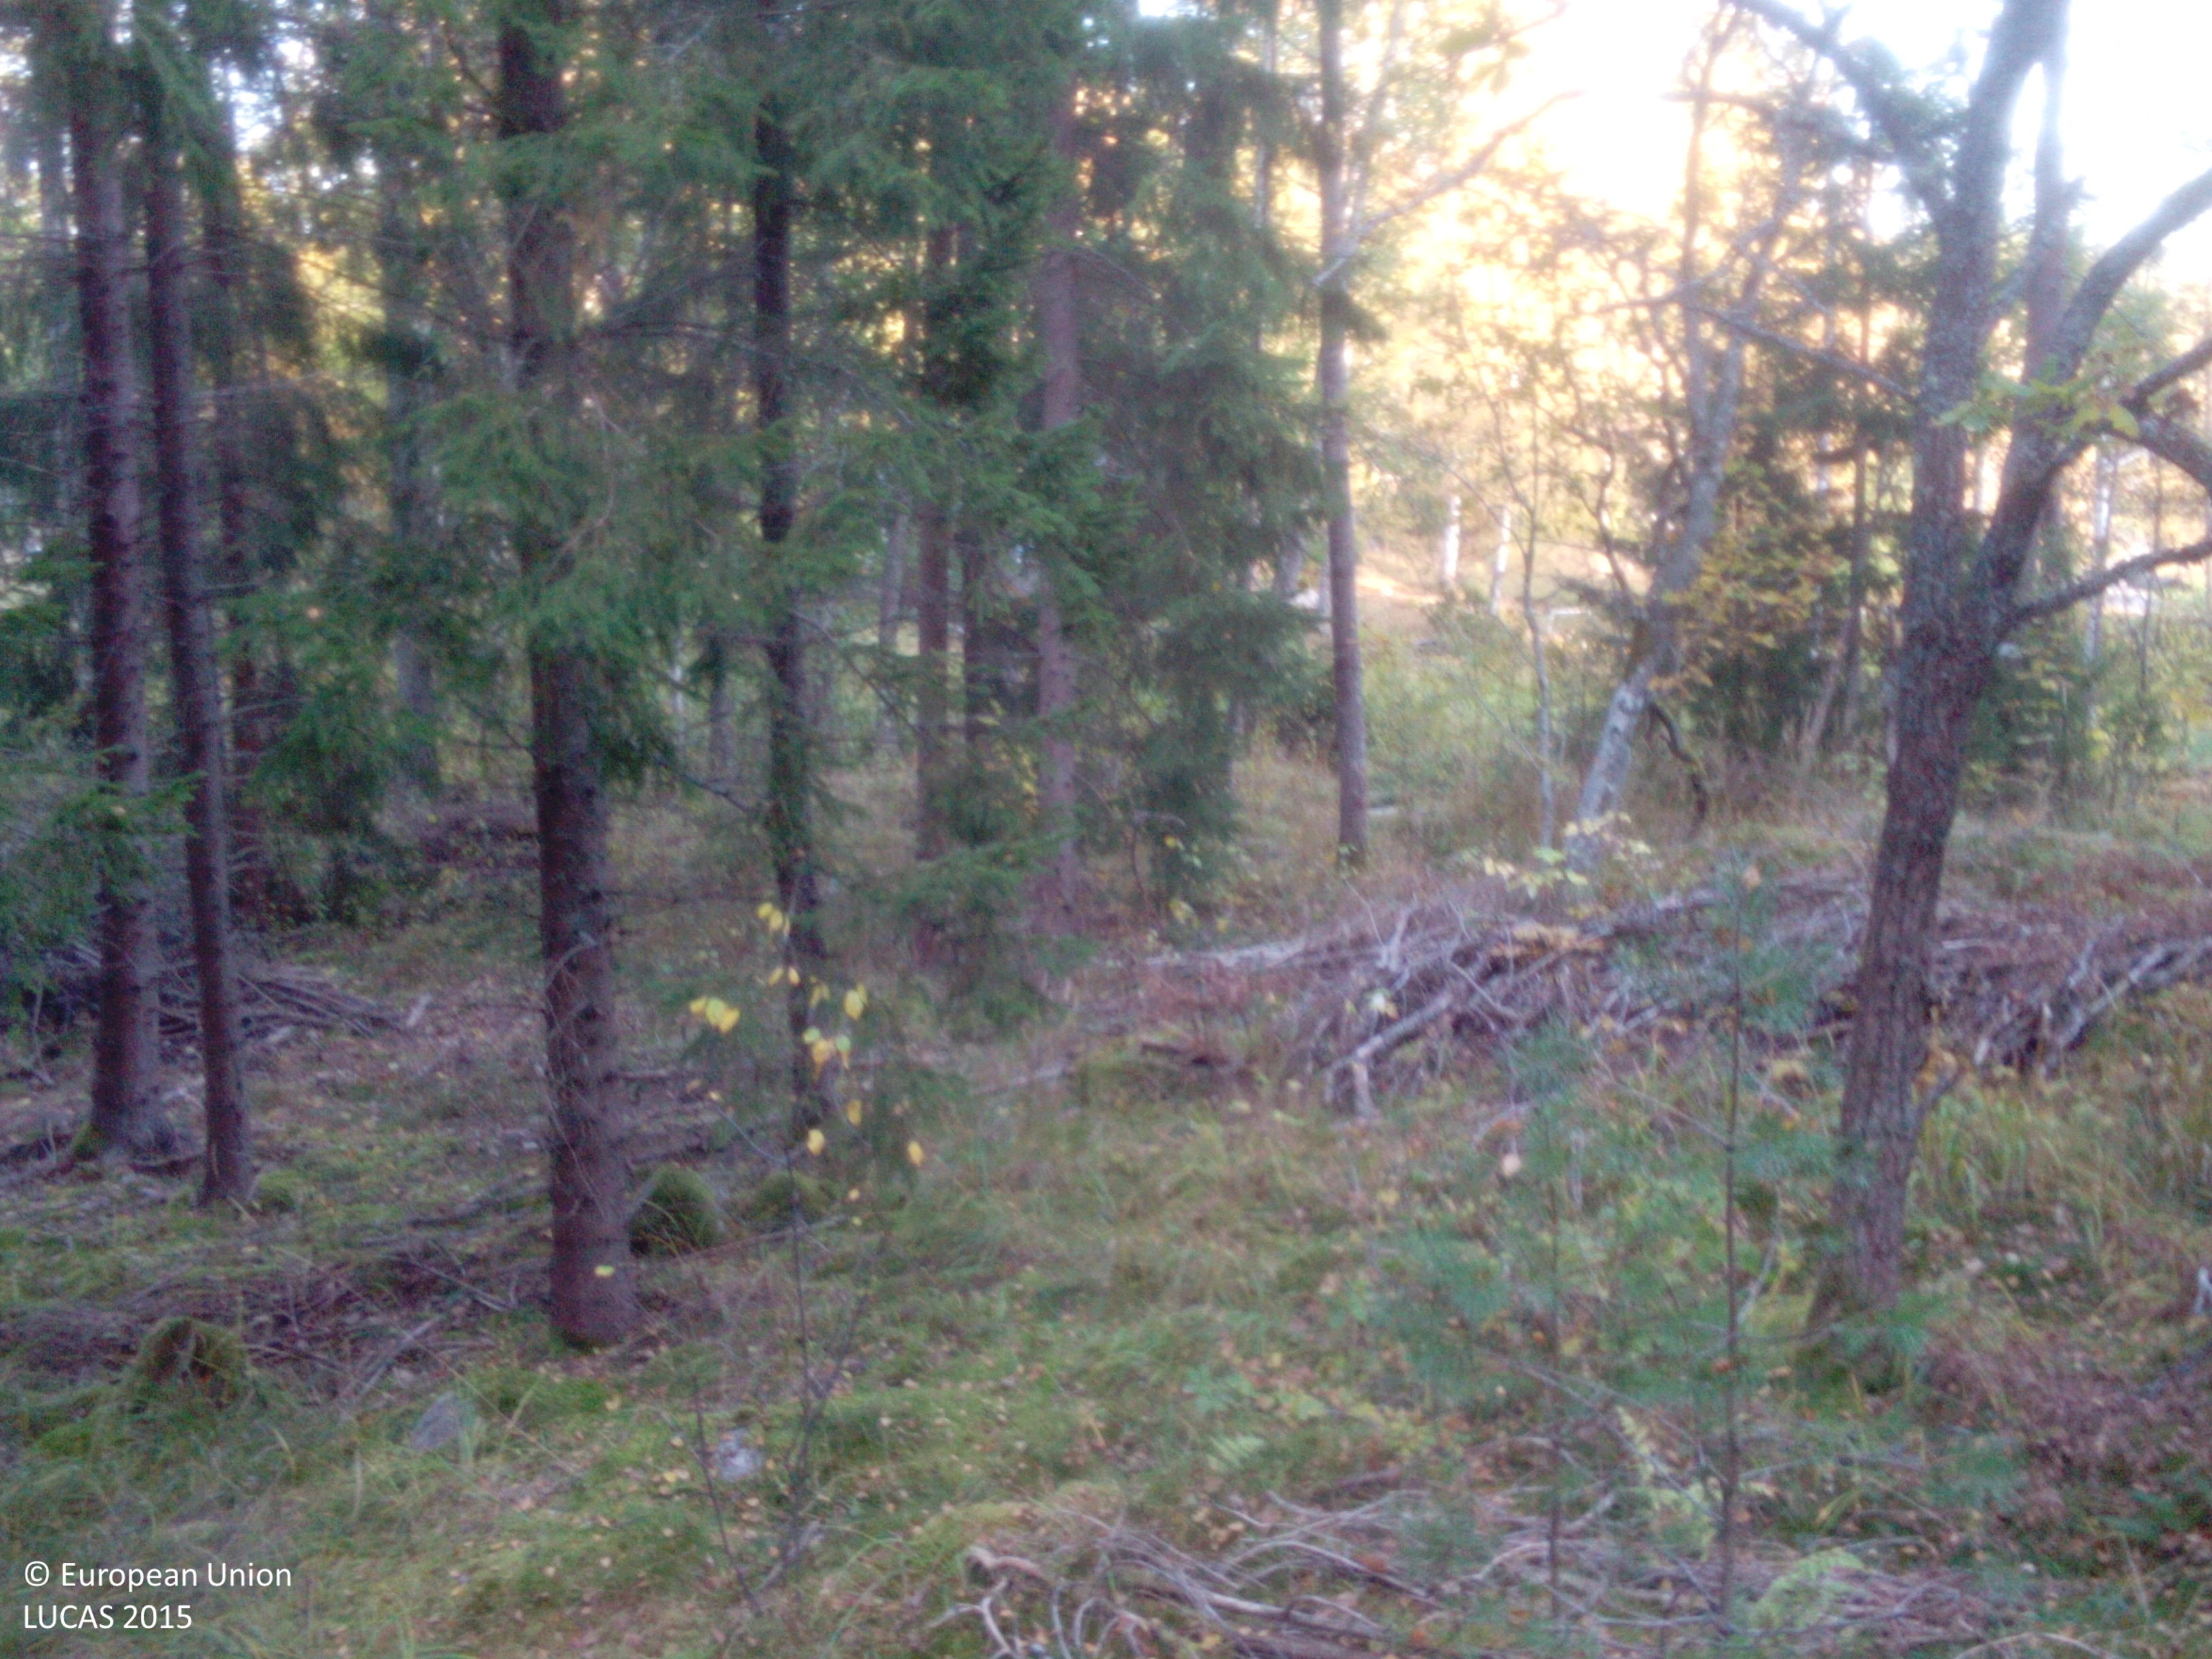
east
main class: Woodland
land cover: Spruce dominated coniferous woodland
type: boreal forest
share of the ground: 50 - 75 %
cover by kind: coniferous forest trees 50 %, herbaceous plants 35 %, broadleaved forest trees 10 %, lichens and mosses 5 %
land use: Forestry
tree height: > 5 m
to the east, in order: Spruce dominated coniferous woodland; Grassland with sparse tree/shrub cover; Broadleaved woodland; Ditches and canals; Grassland without tree/shrub cover; Artificial constructions in urban areas; Other mixed woodland; Spruce dominated mixed woodland; Spruce dominated coniferous woodland; Inland marshes; Spruce dominated coniferous woodland
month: October
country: SE
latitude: 58.8455
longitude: 16.3546
